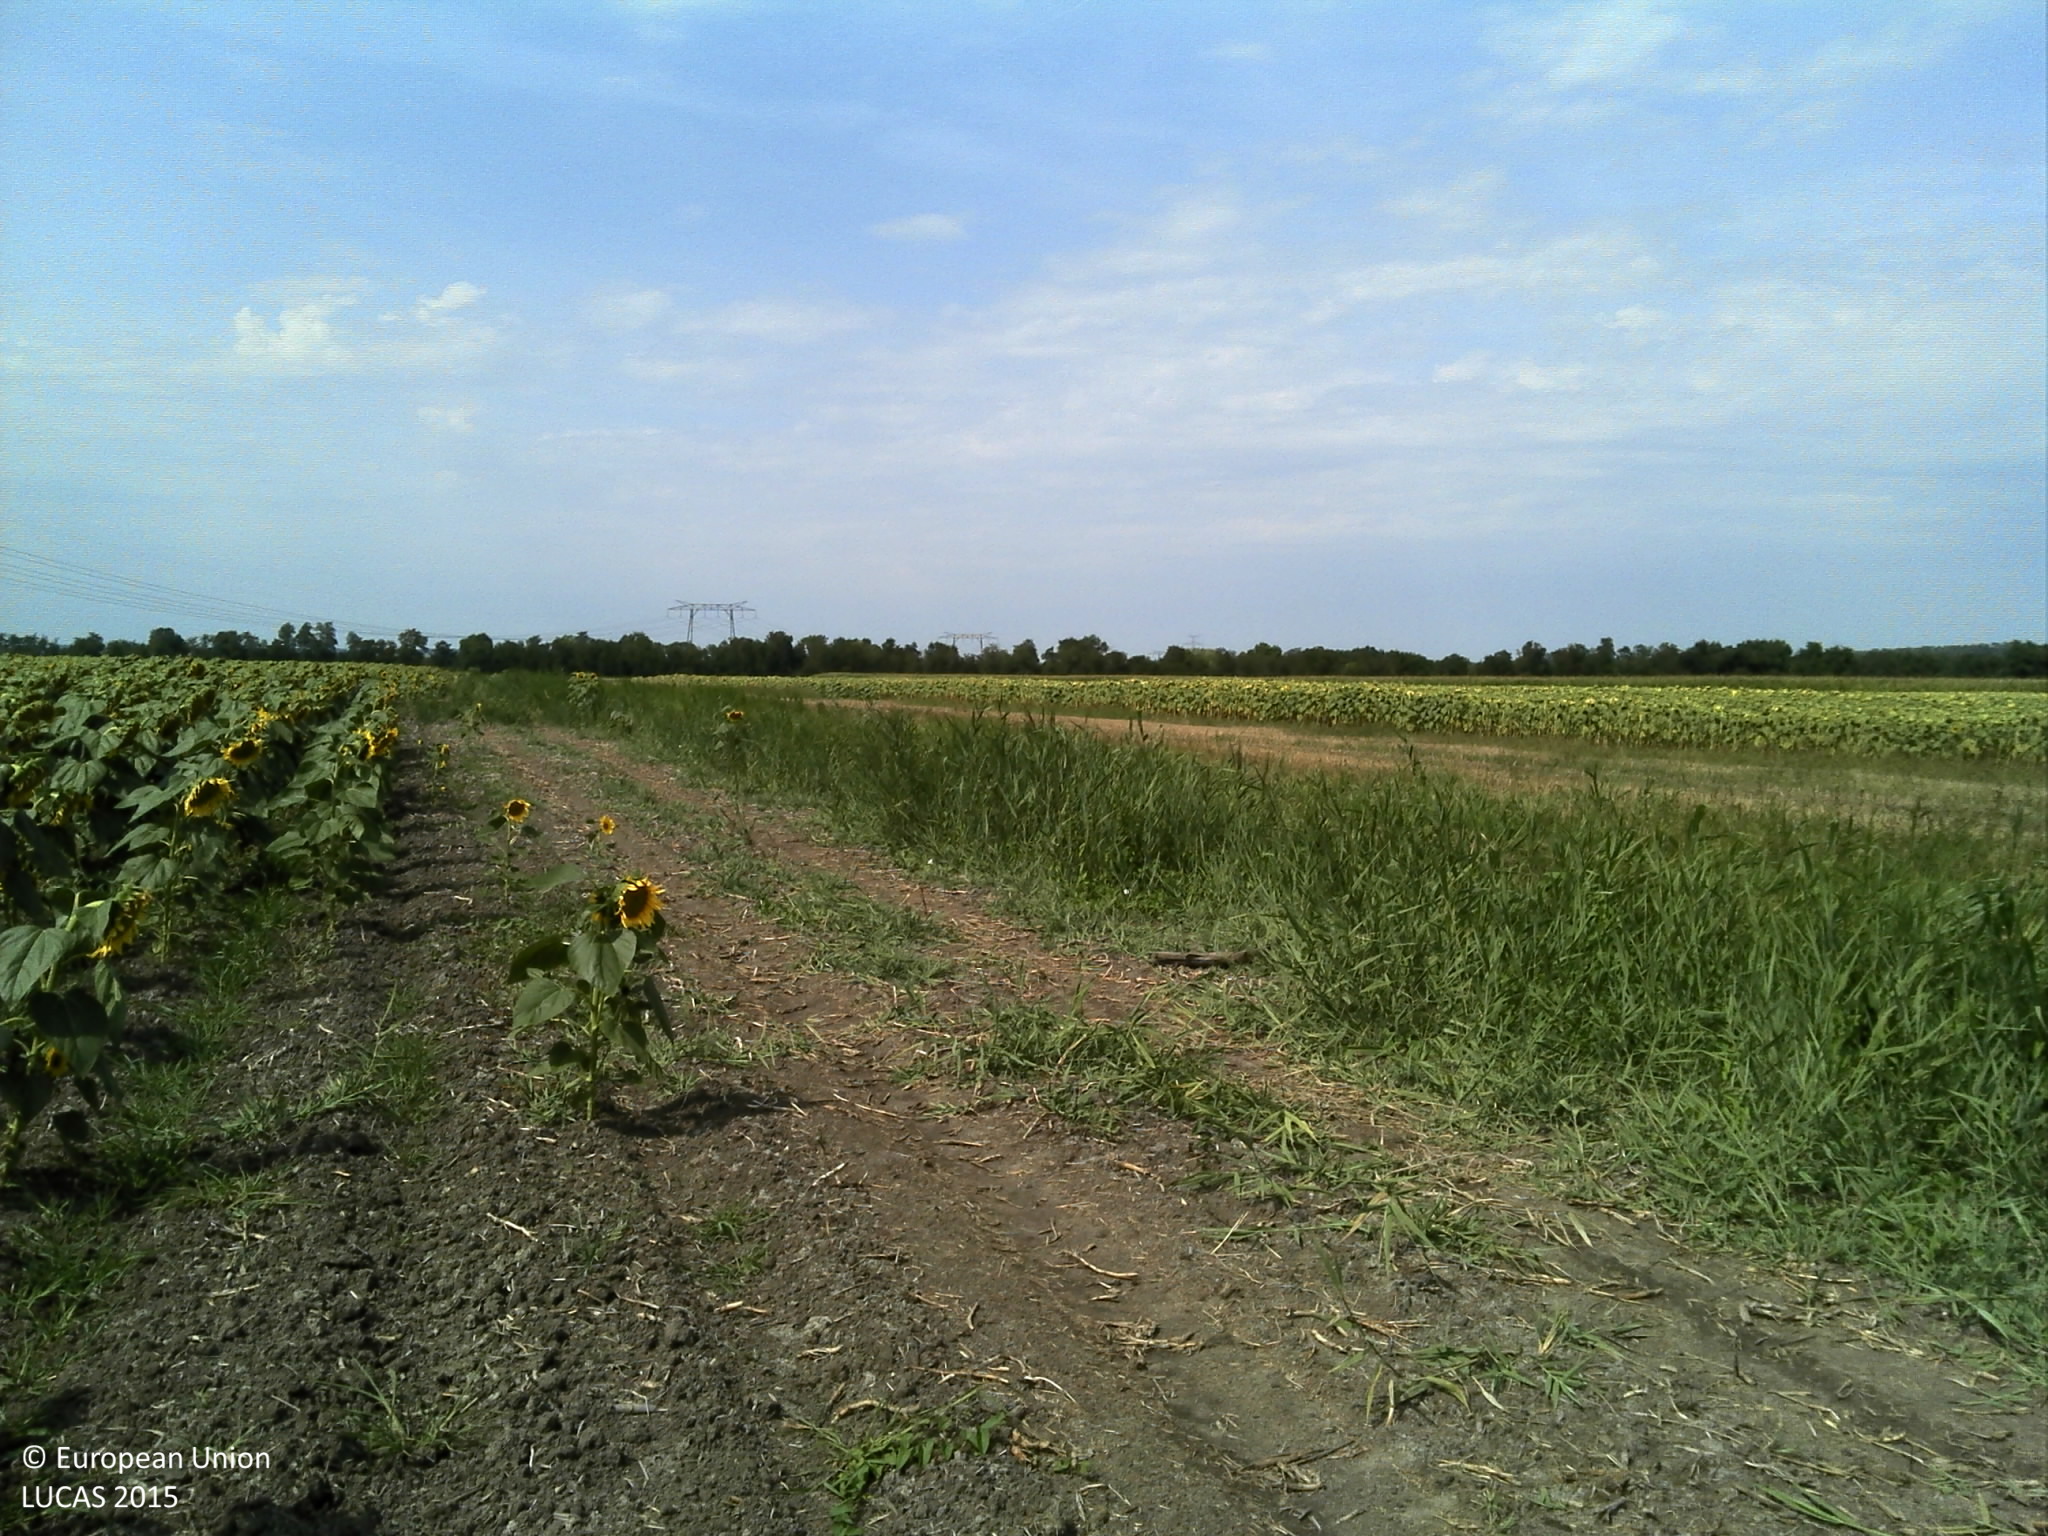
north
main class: Cropland
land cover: Sunflower
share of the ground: > 75 %
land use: Agriculture (excluding fallow land and kitchen gardens)
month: August
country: FR
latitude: 45.3097
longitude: -0.6466
